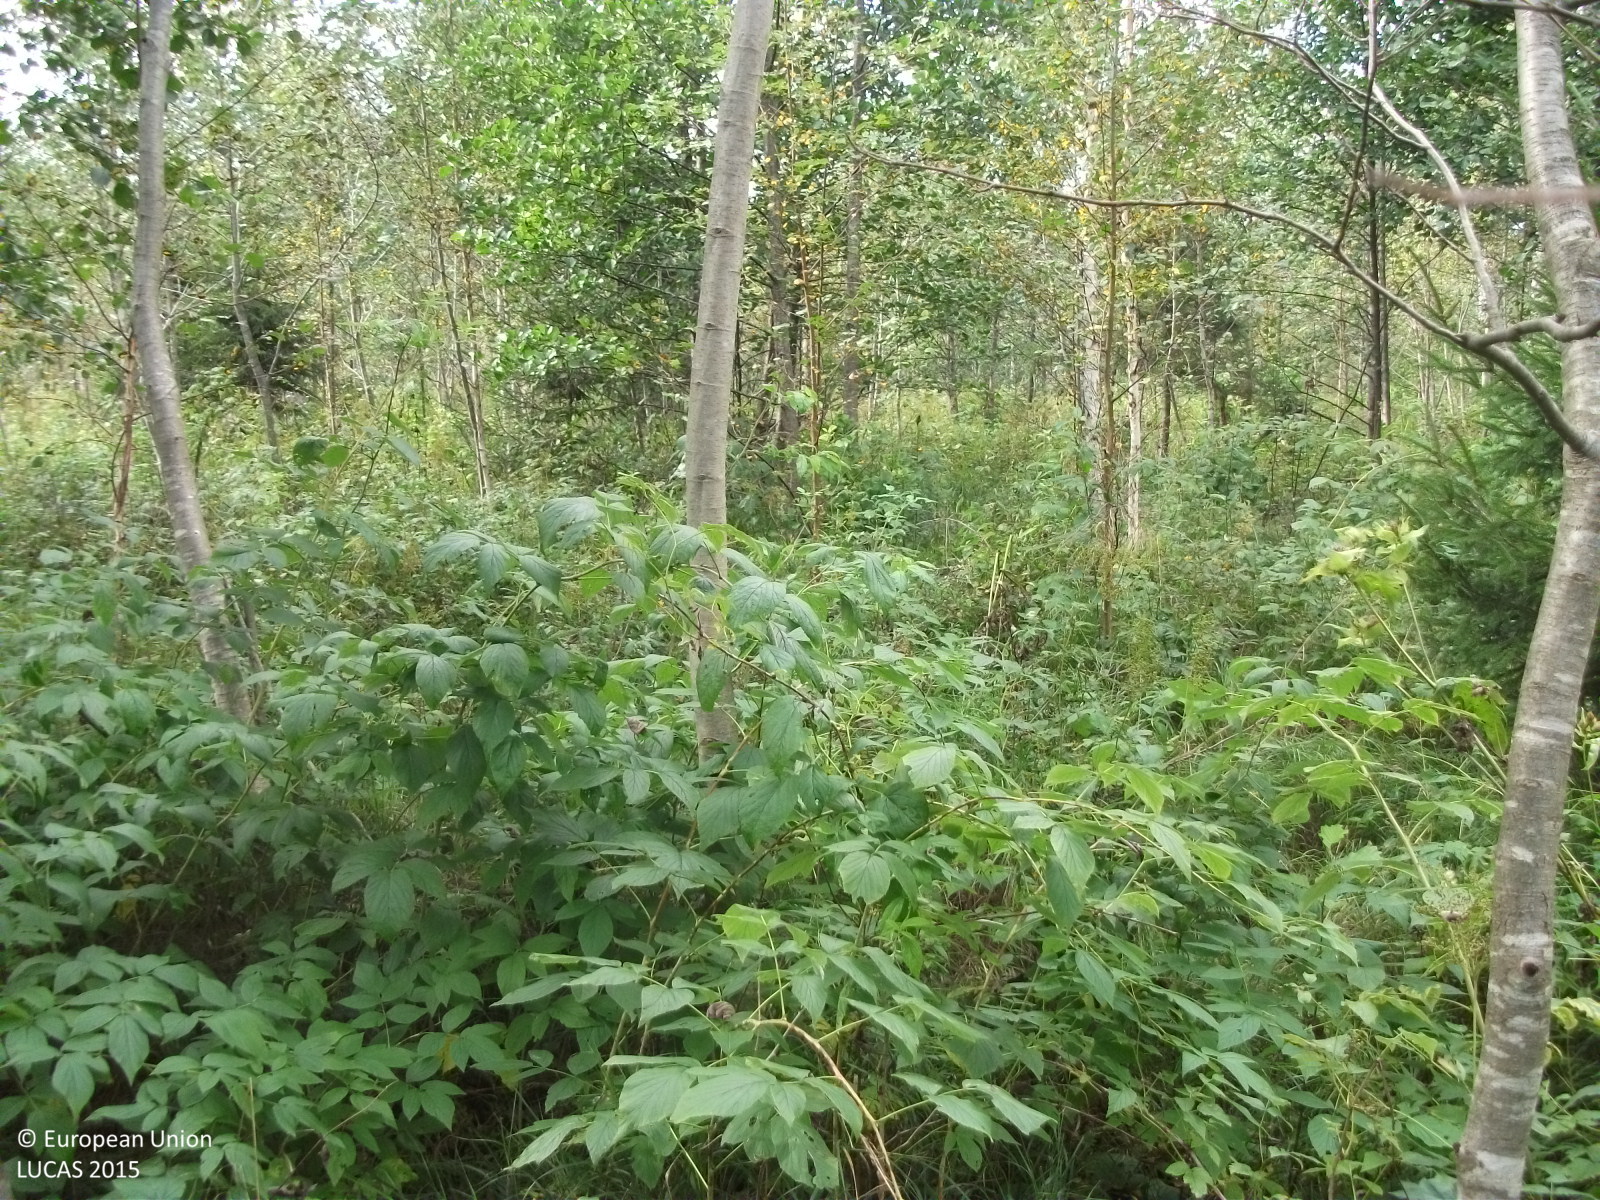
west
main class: Woodland
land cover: Broadleaved woodland
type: non-riverine alder, birch or aspen forest
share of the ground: 50 - 75 %
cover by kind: broadleaved forest trees 70 %, herbaceous plants 15 %, shrubs 10 %, coniferous forest trees 5 %
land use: Forestry
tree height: > 5 m
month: September
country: LV
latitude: 57.9352
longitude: 24.8748
